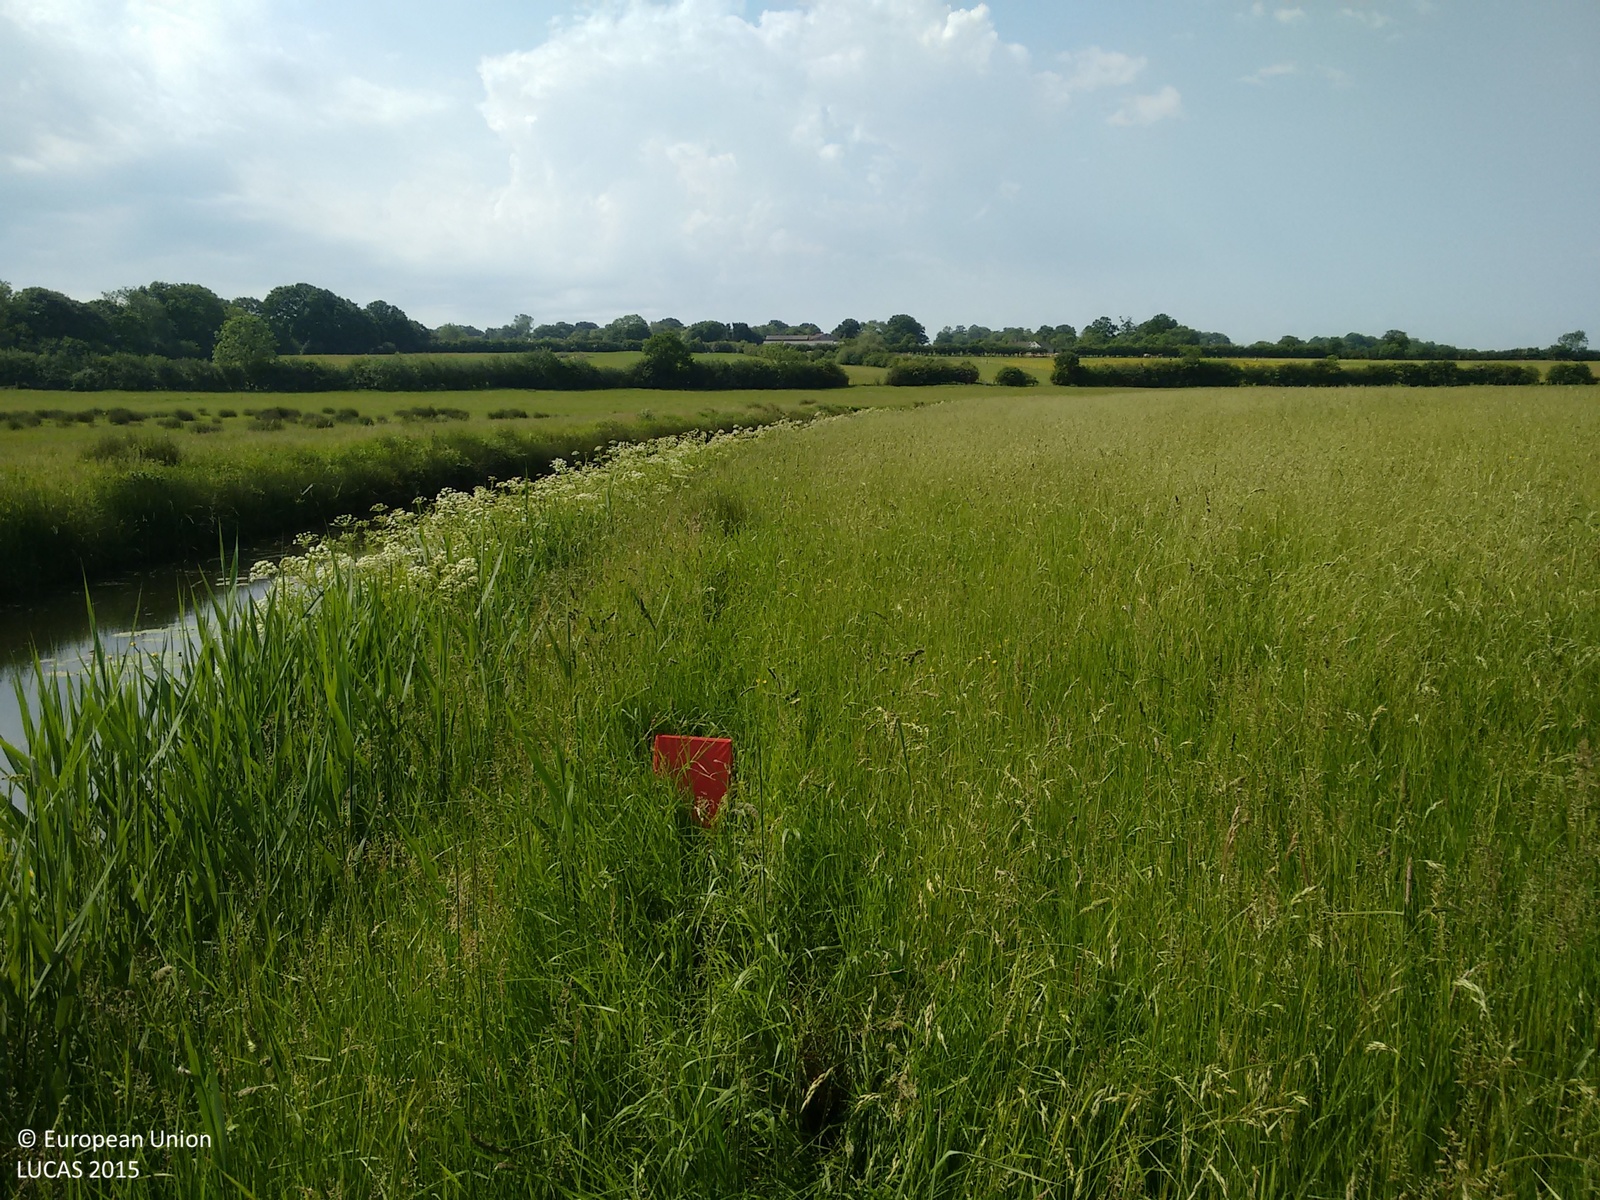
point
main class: Grassland
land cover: Grassland without tree/shrub cover
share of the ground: > 75 %
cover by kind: herbaceous plants 100 %
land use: Agriculture (excluding fallow land and kitchen gardens)
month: June
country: GB
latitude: 51.0336
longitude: 0.6906
